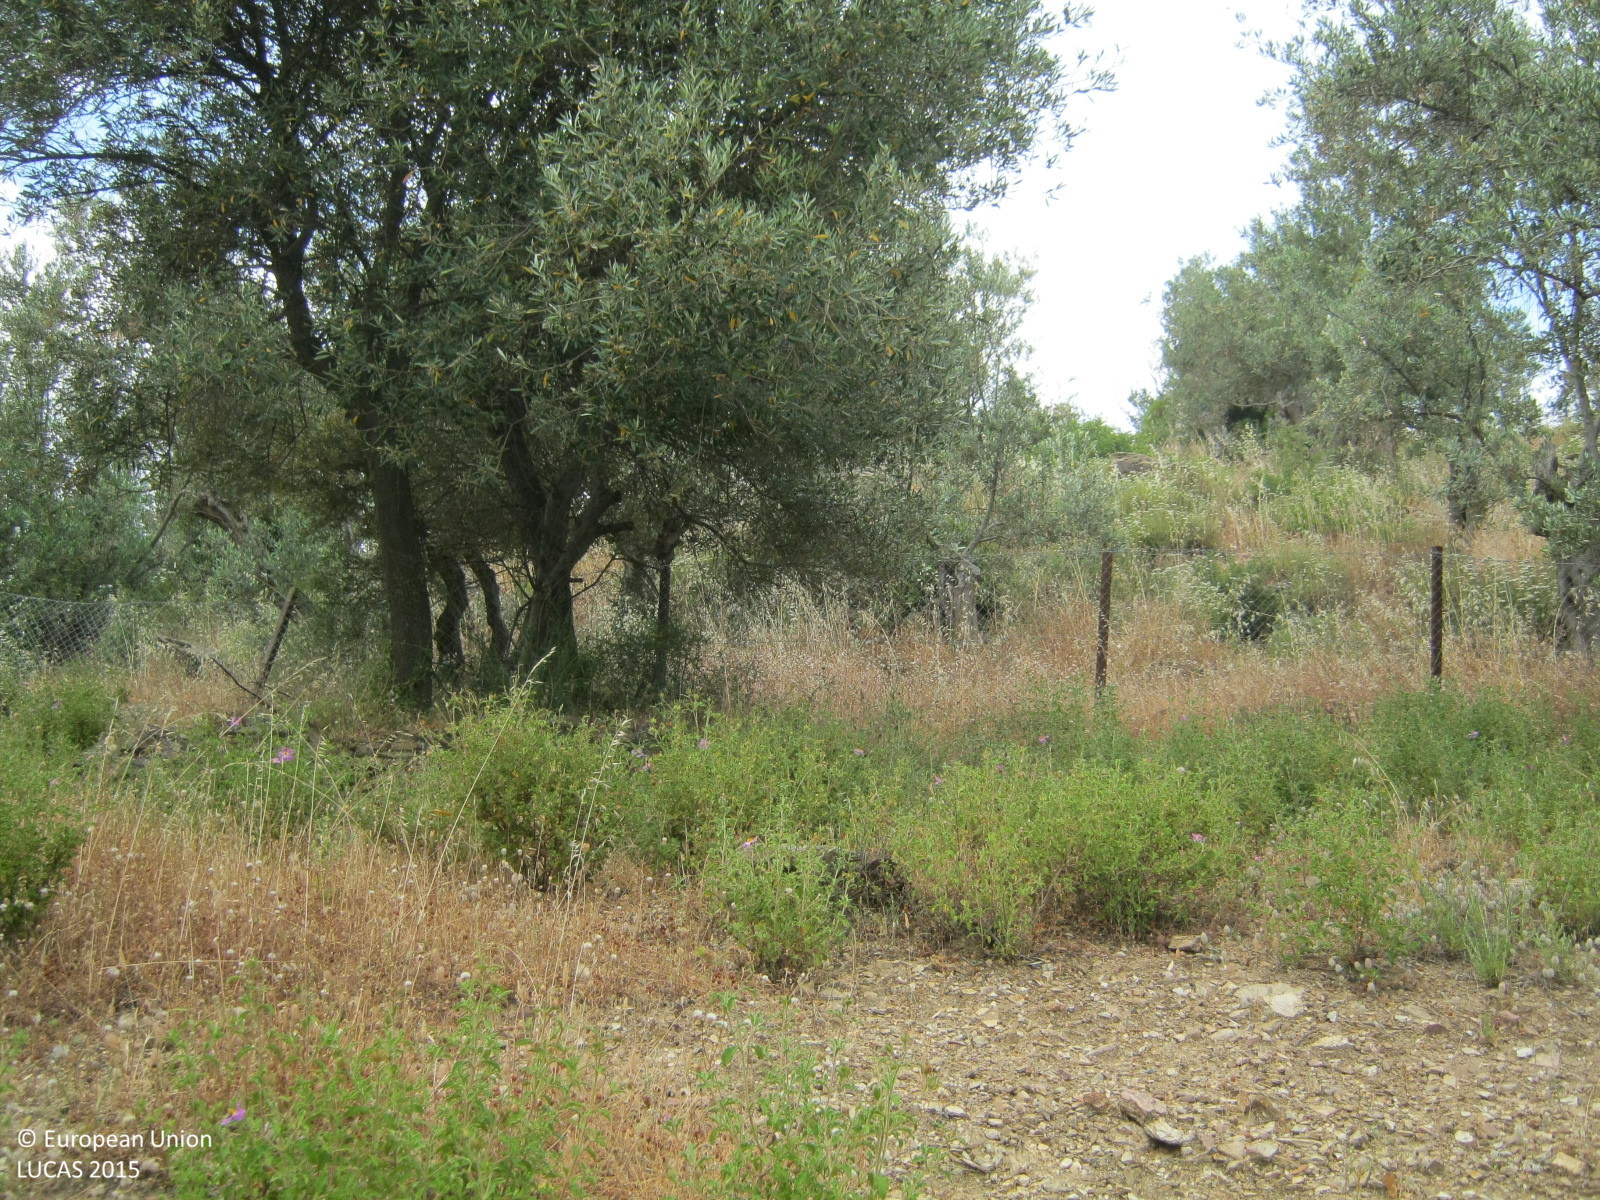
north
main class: Cropland
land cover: Olive groves
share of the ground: > 75 %
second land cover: Spontaneously vegetated surfaces
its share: > 75 %
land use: Agriculture (excluding fallow land and kitchen gardens)
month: May
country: GR
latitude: 38.9763
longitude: 26.4635
